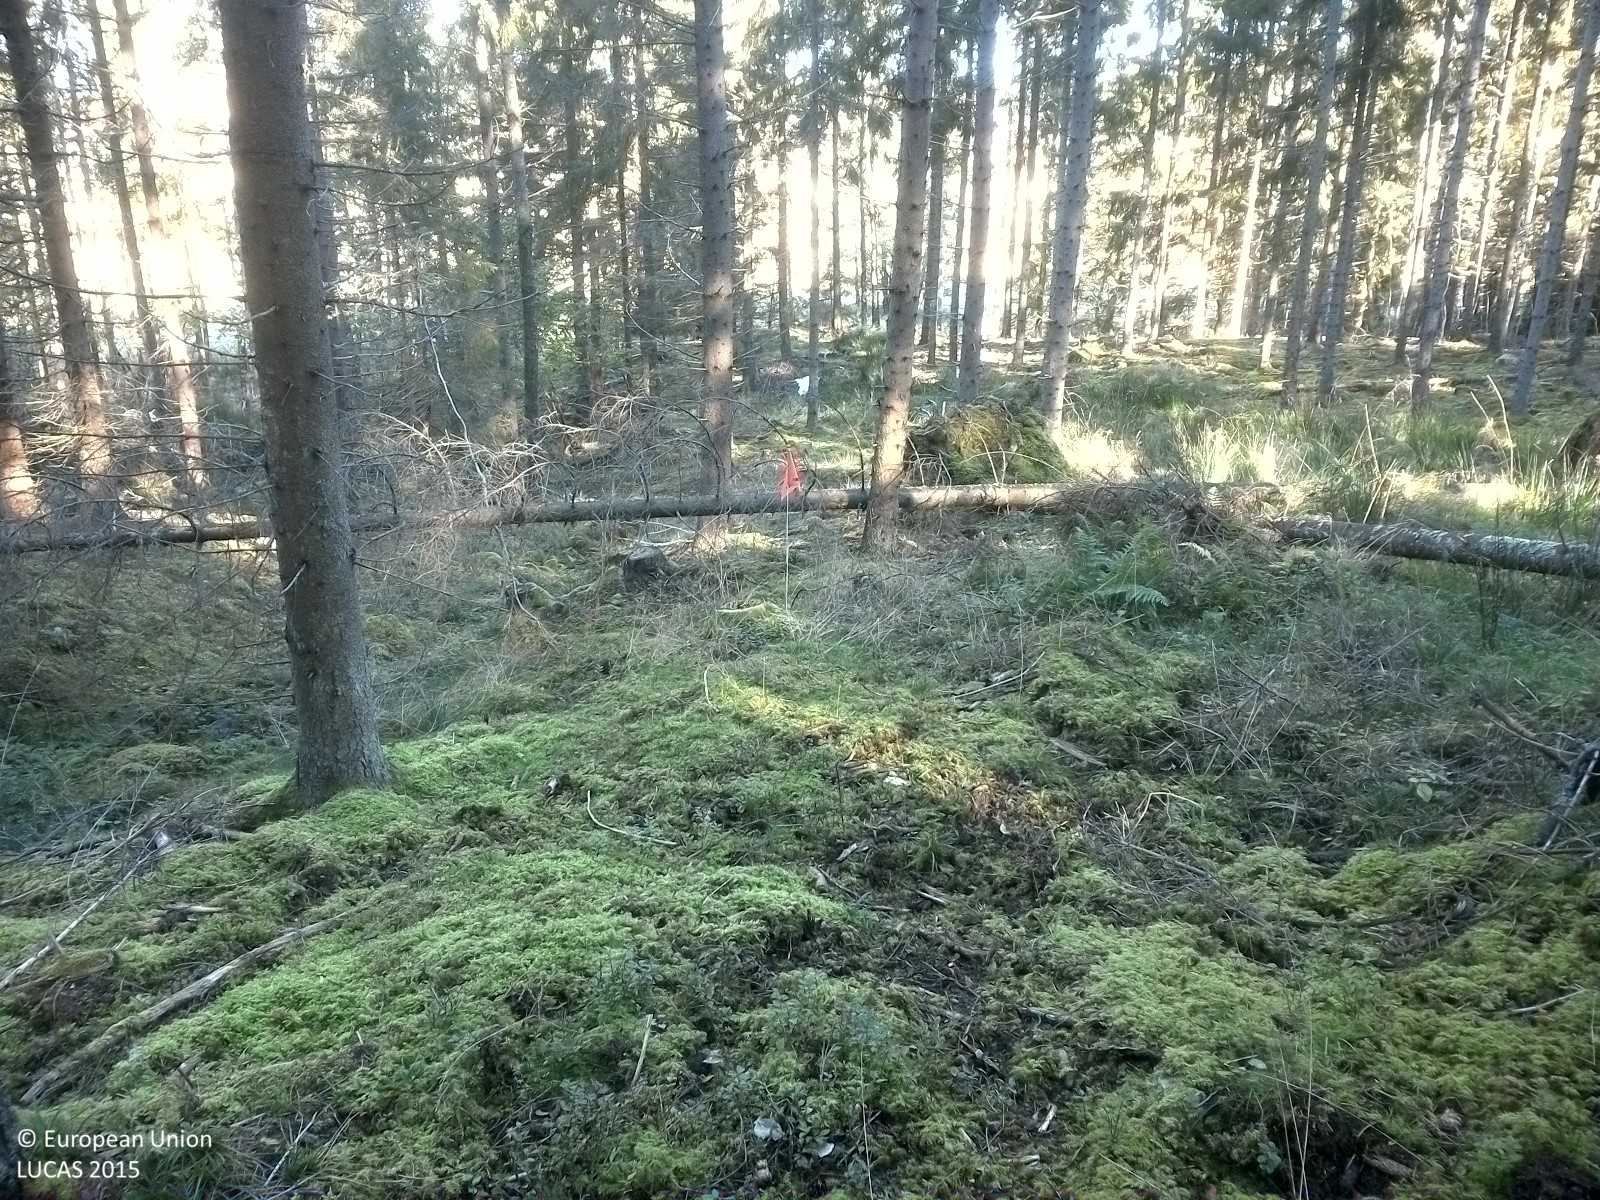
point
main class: Woodland
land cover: Spruce dominated coniferous woodland
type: boreal forest
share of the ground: 25 - 50 %
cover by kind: lichens and mosses 40 %, coniferous forest trees 30 %, herbaceous plants 30 %
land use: Forestry
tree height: > 5 m
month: September
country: SE
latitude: 58.7345
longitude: 16.7850
